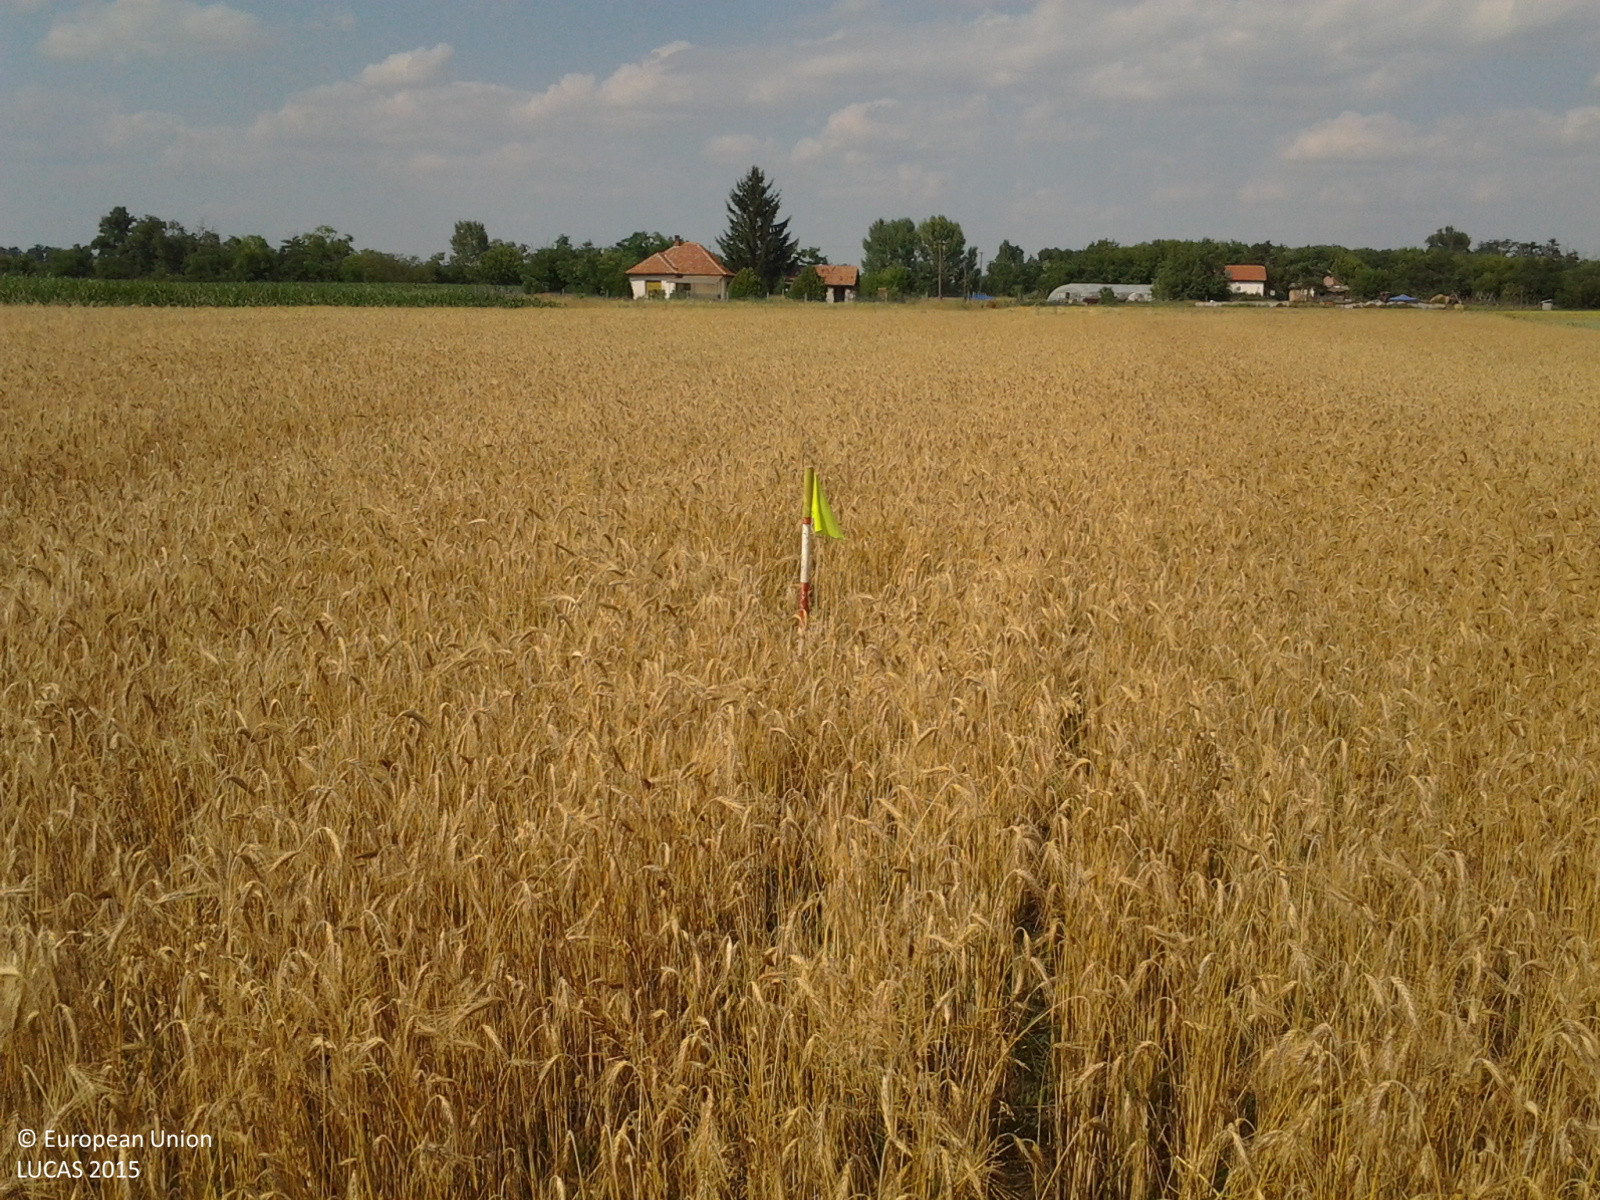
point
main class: Cropland
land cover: Triticale
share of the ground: > 75 %
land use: Agriculture (excluding fallow land and kitchen gardens)
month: July
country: HU
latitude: 47.4572
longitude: 19.8266
